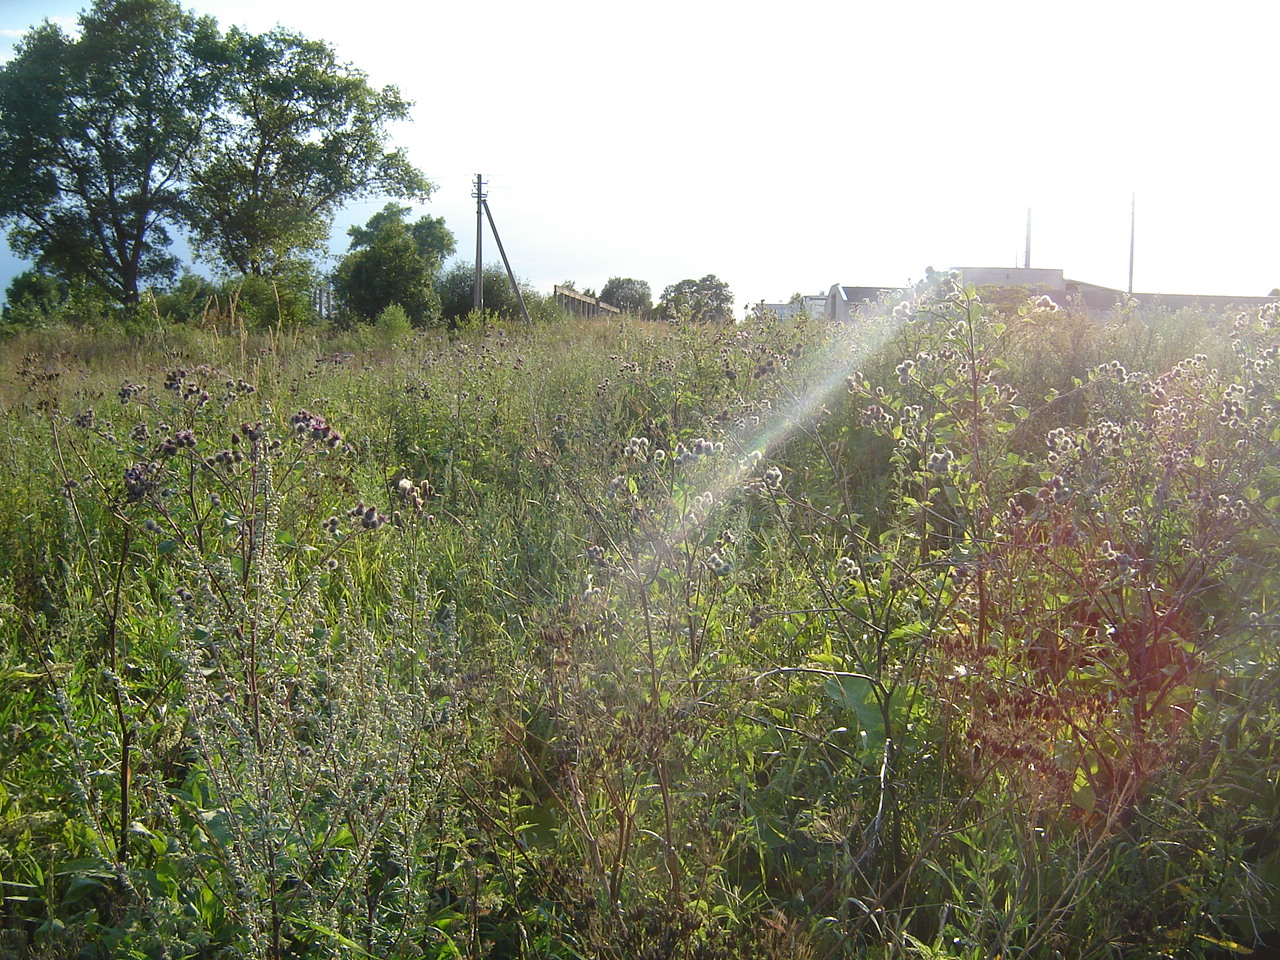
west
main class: Grassland
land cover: Spontaneously vegetated surfaces
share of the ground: > 75 %
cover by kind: herbaceous plants 100 %
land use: Fallow land
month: July
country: LT
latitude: 55.2972
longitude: 24.7055
